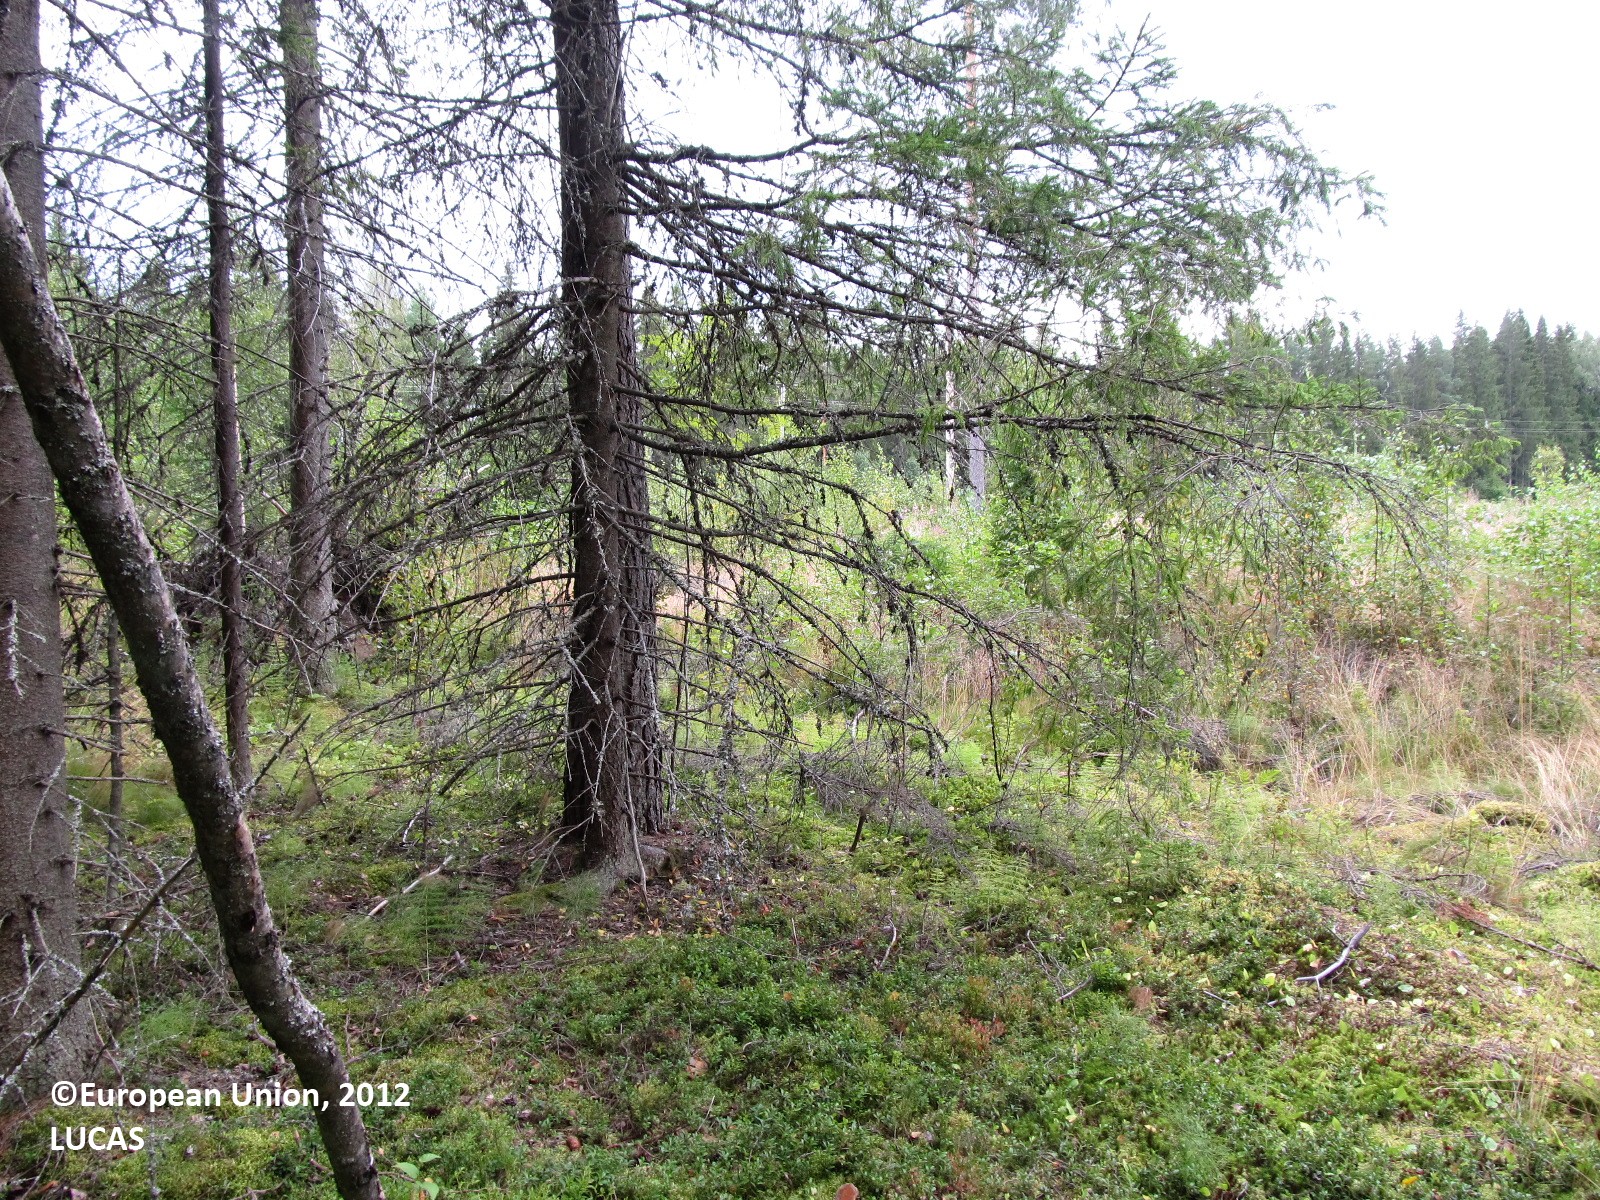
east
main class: Woodland
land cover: Pine dominated mixed woodland
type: boreal forest
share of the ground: 25 - 50 %
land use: Forestry
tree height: > 5 m
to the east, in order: Pine dominated mixed woodland; Shrubland with sparse tree cover; Tracks; Shrubland with sparse tree cover; Ditches and canals; Shrubland with sparse tree cover; Ditches and canals; Electric lines; Paved roads, cycling and walking lanes; Ditches and canals; Spruce dominated coniferous woodland; Ditches and canals; Spruce dominated coniferous woodland; Ditches and canals; Spruce dominated mixed woodland; Pine dominated coniferous woodland
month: August
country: FI
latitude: 62.0542
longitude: 27.5216
